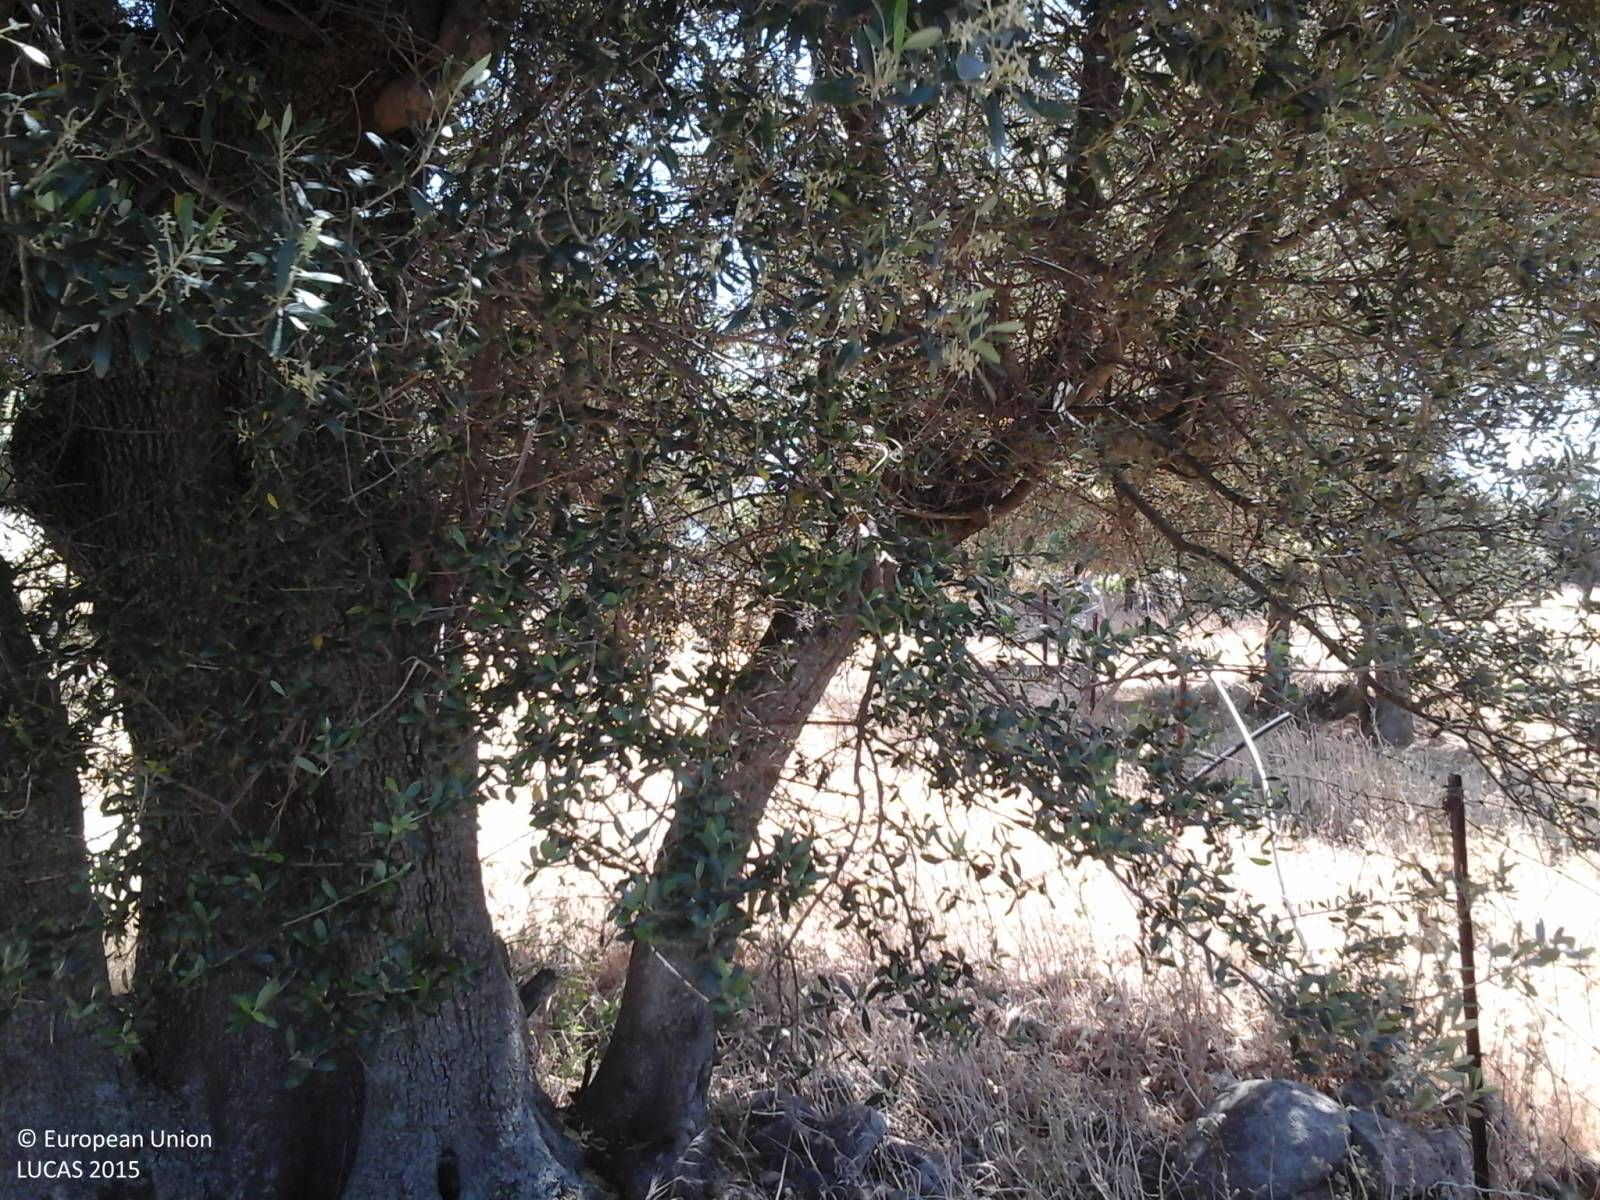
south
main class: Cropland
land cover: Olive groves
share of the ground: > 75 %
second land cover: Grassland without tree/shrub cover
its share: > 75 %
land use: Agriculture (excluding fallow land and kitchen gardens)
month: May
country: IT
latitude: 40.3202
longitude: 9.4732
